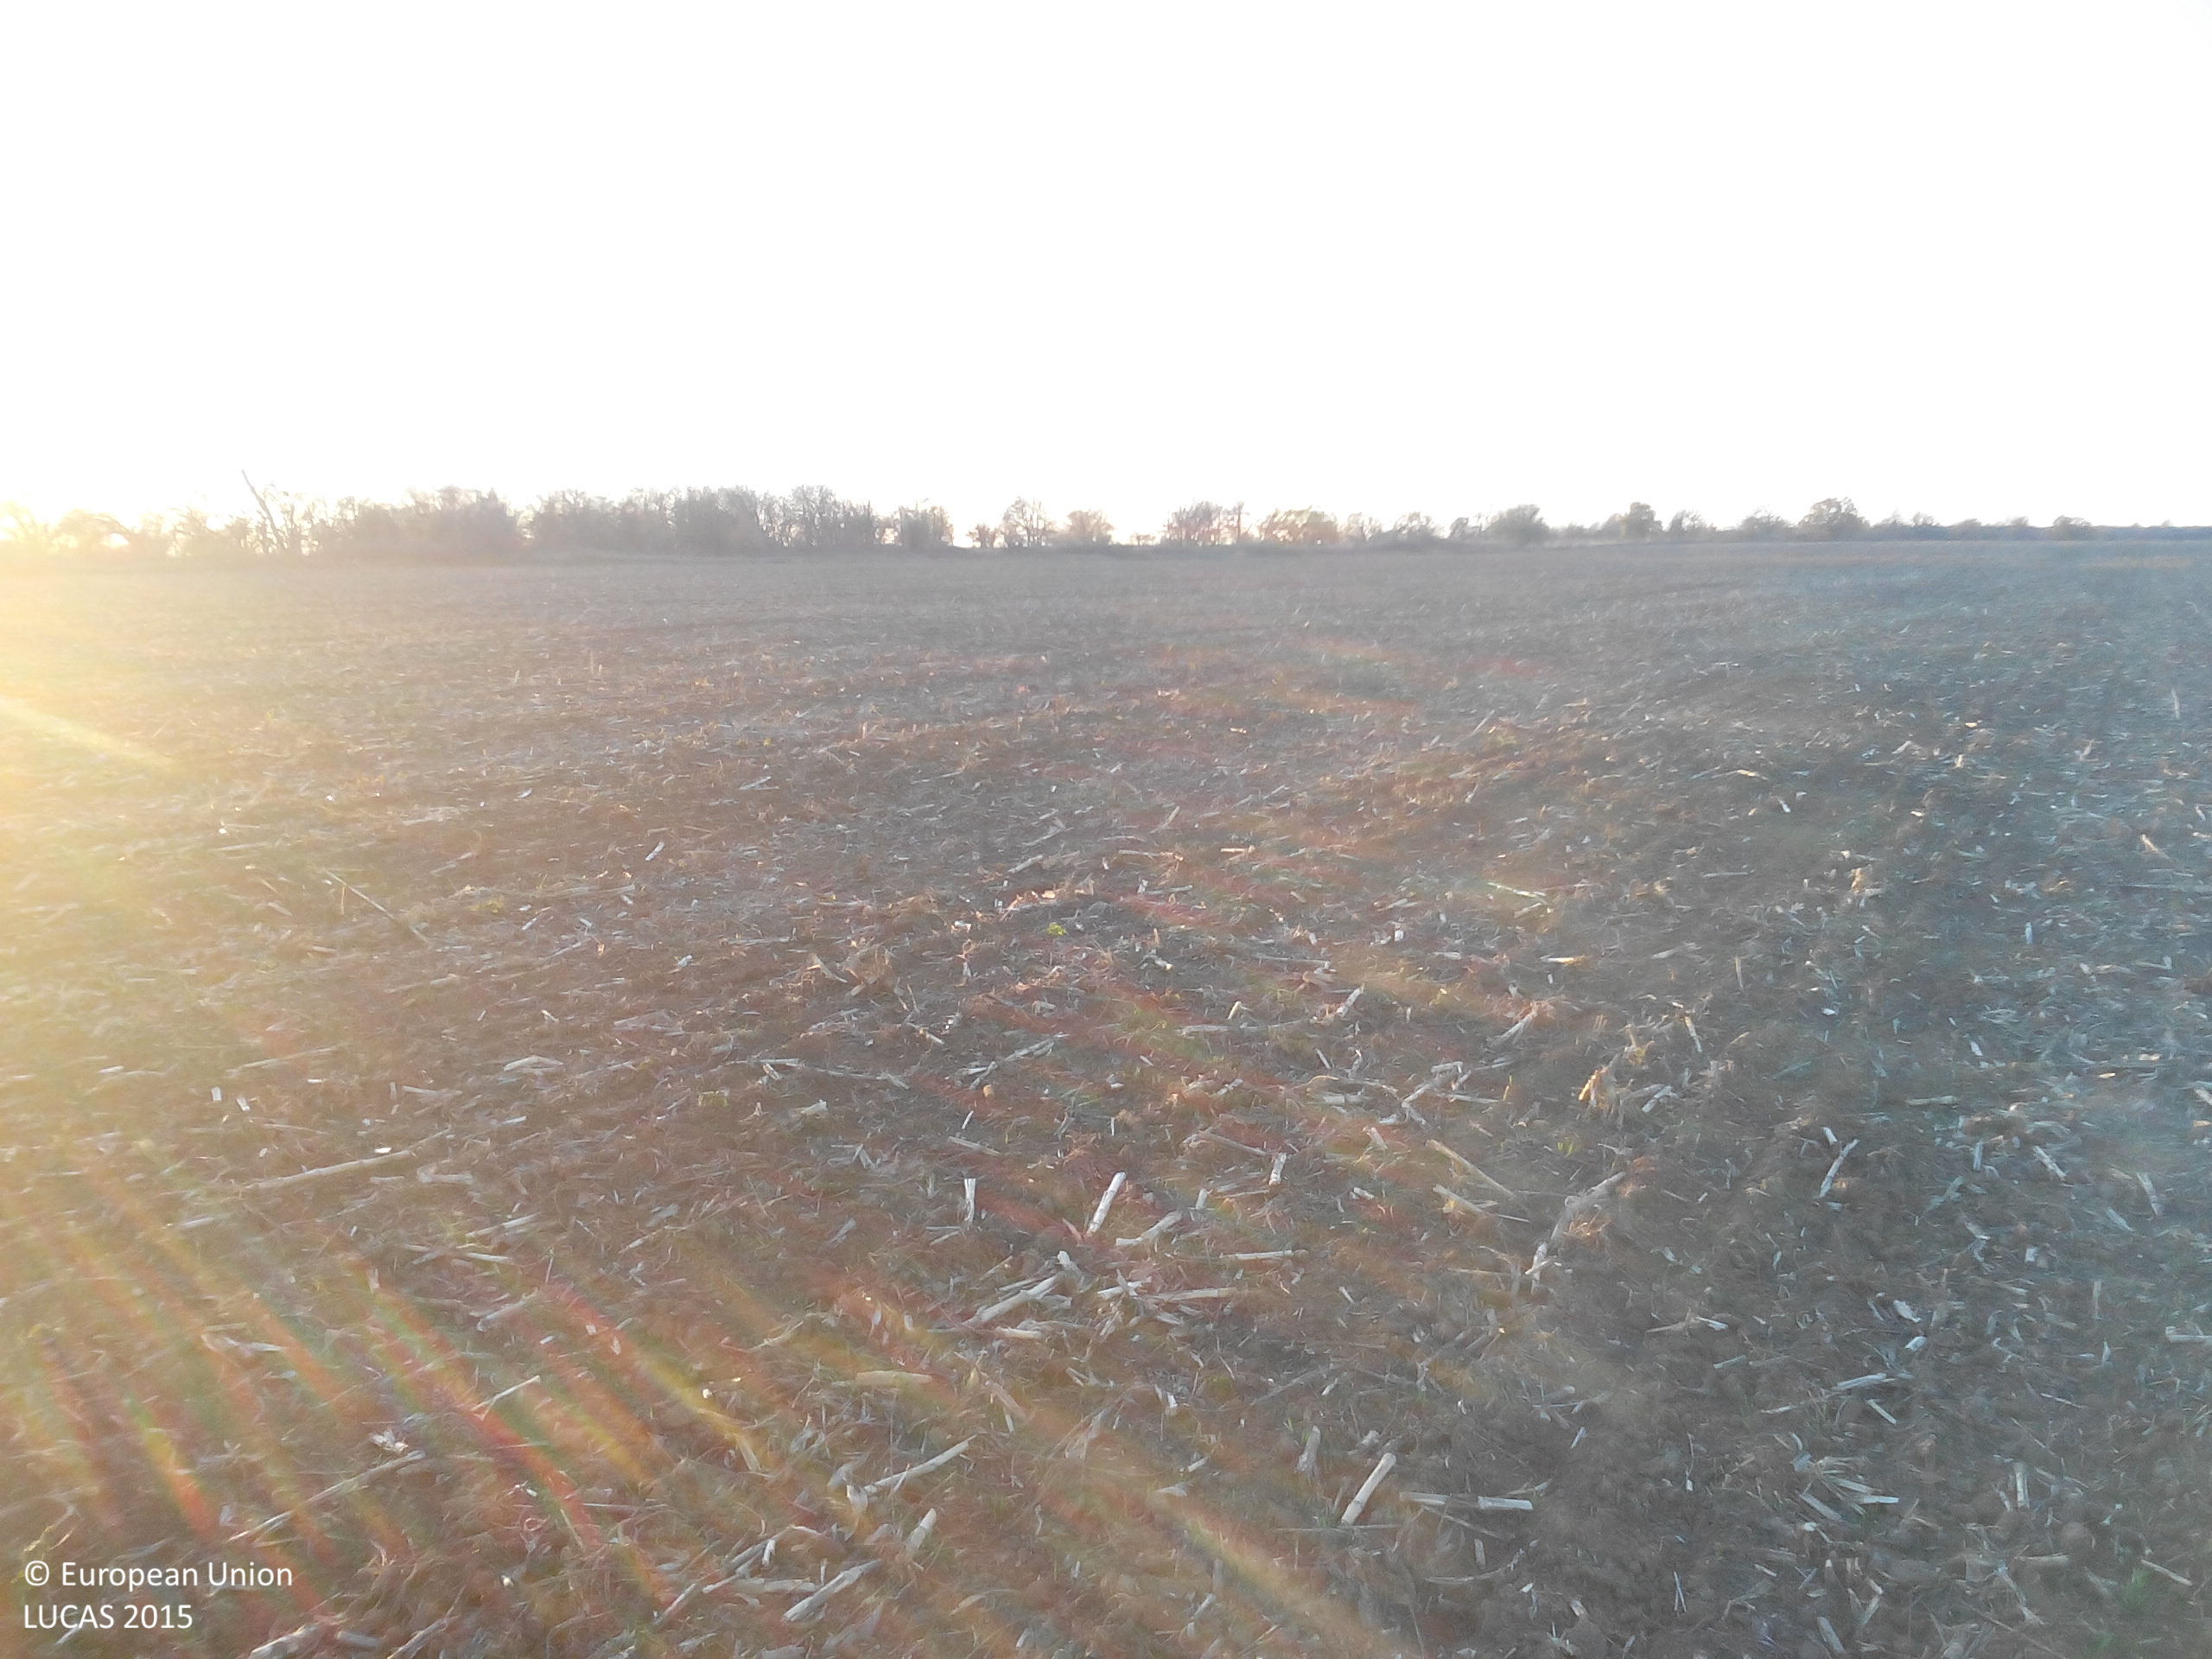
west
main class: Cropland
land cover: Maize
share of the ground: < 10 %
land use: Agriculture (excluding fallow land and kitchen gardens)
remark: Harvested field
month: November
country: BG
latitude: 43.2380
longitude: 23.9523
